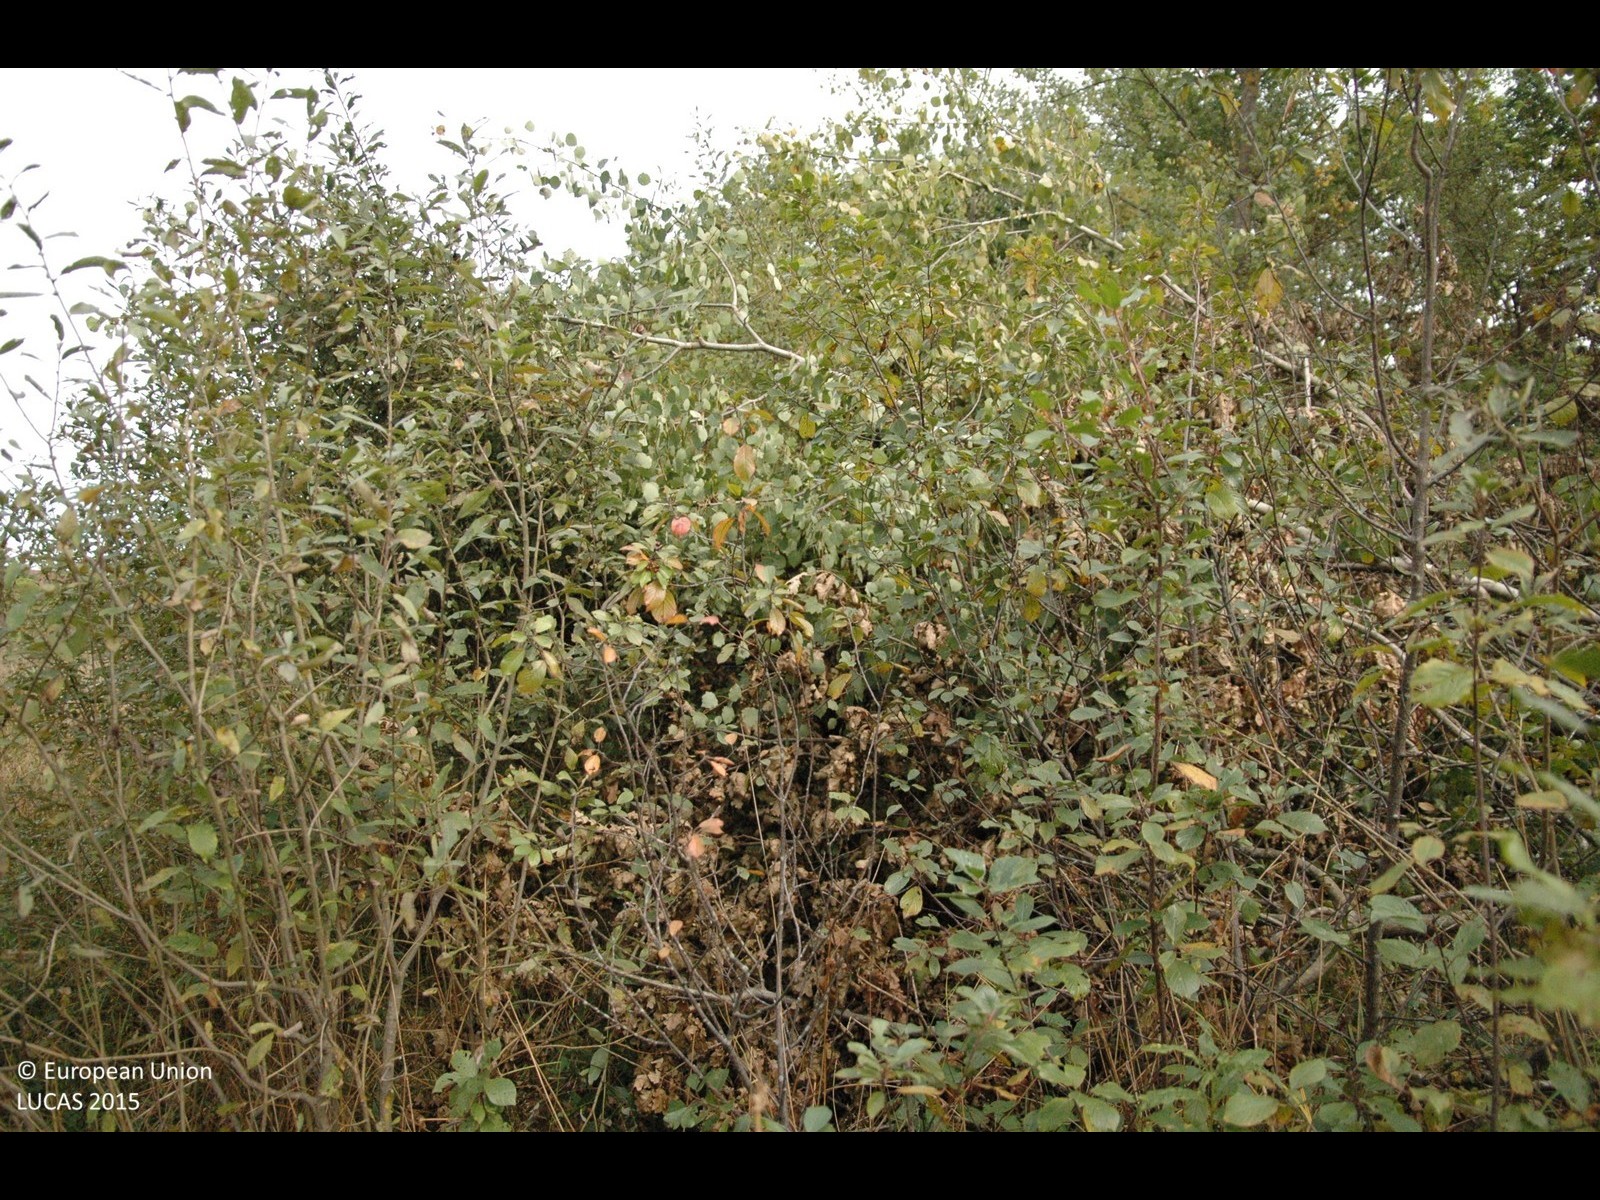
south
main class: Artificial land
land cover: Non built-up linear features
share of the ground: 10 - 25 %
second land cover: Spontaneously vegetated surfaces
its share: > 75 %
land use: Electricity, gas and thermal power distribution
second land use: Protection infrastructures
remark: Clear cut
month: October
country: HR
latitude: 45.5744
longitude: 16.2128
